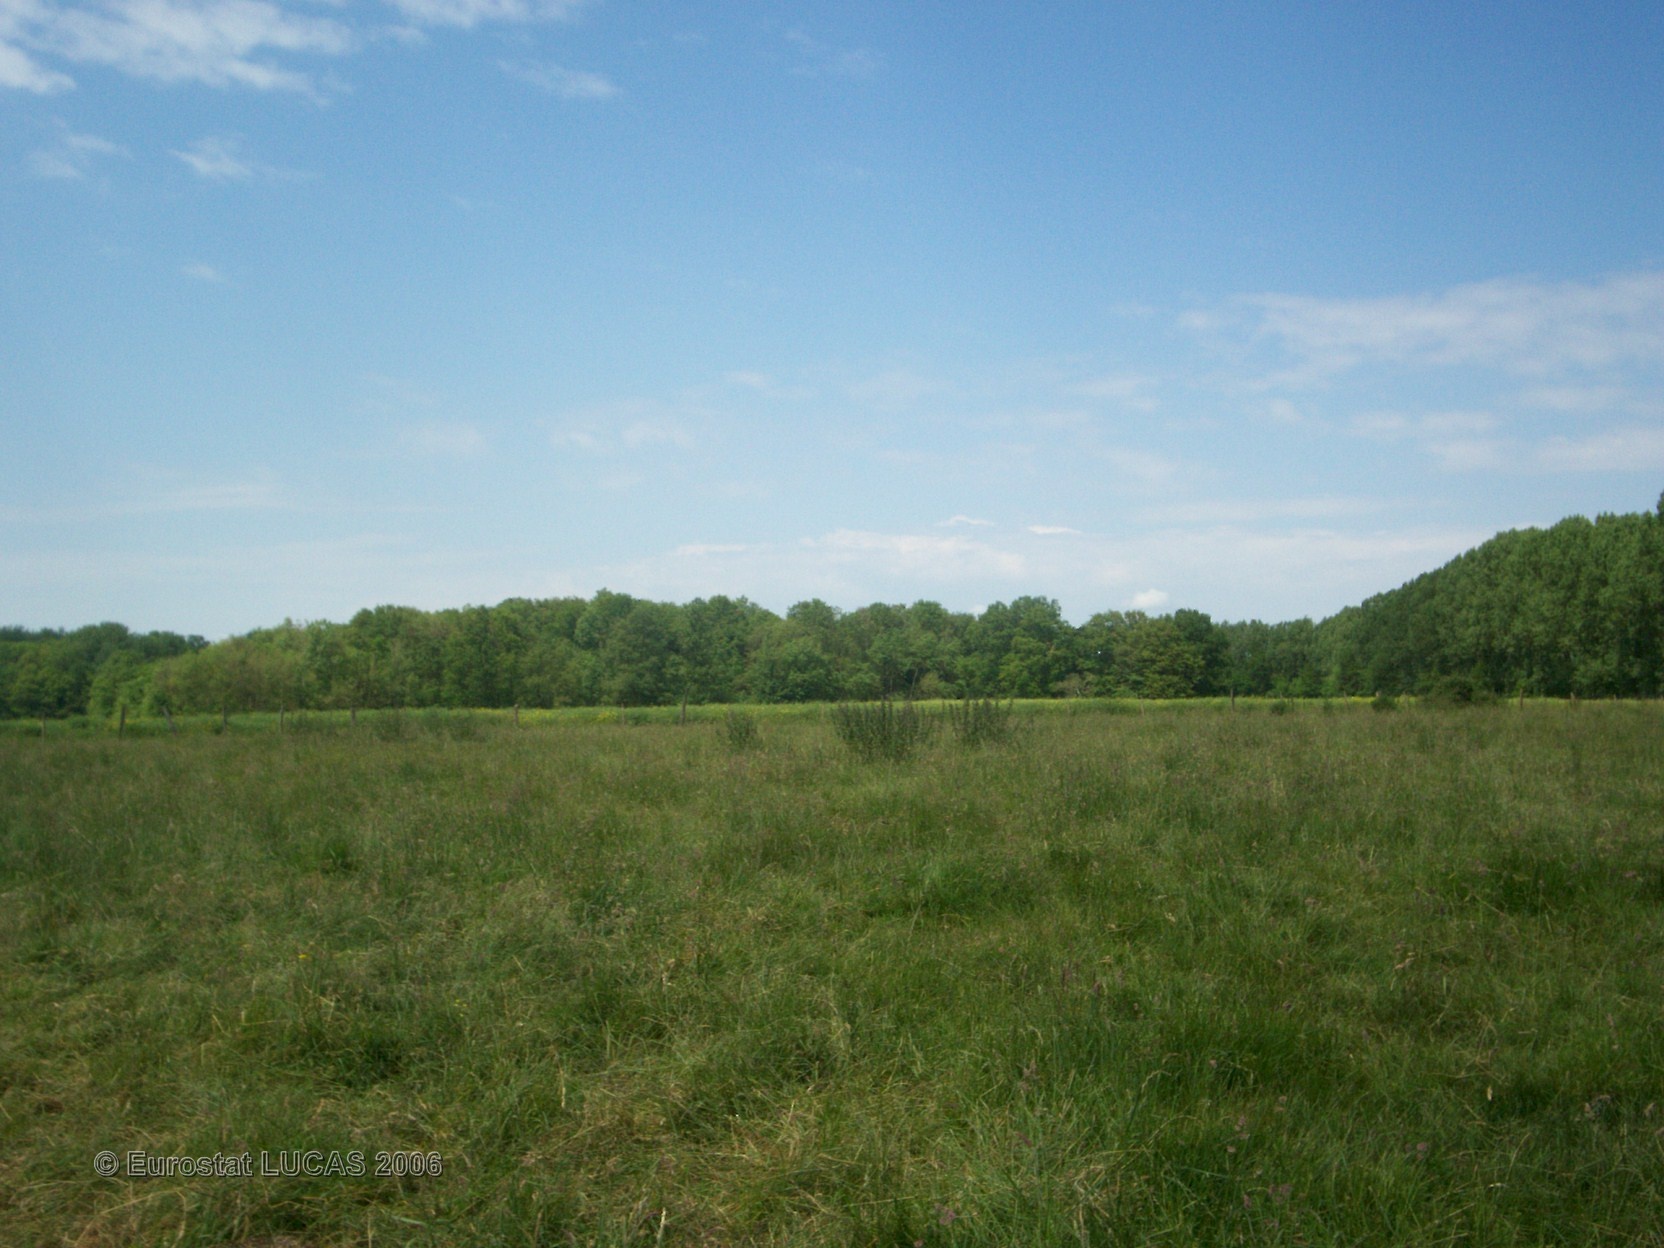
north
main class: Grassland
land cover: Grassland with sparse tree/shrub cover
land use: Agriculture (excluding fallow land and kitchen gardens)
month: June
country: FR
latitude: 49.4065
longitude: 2.6709
